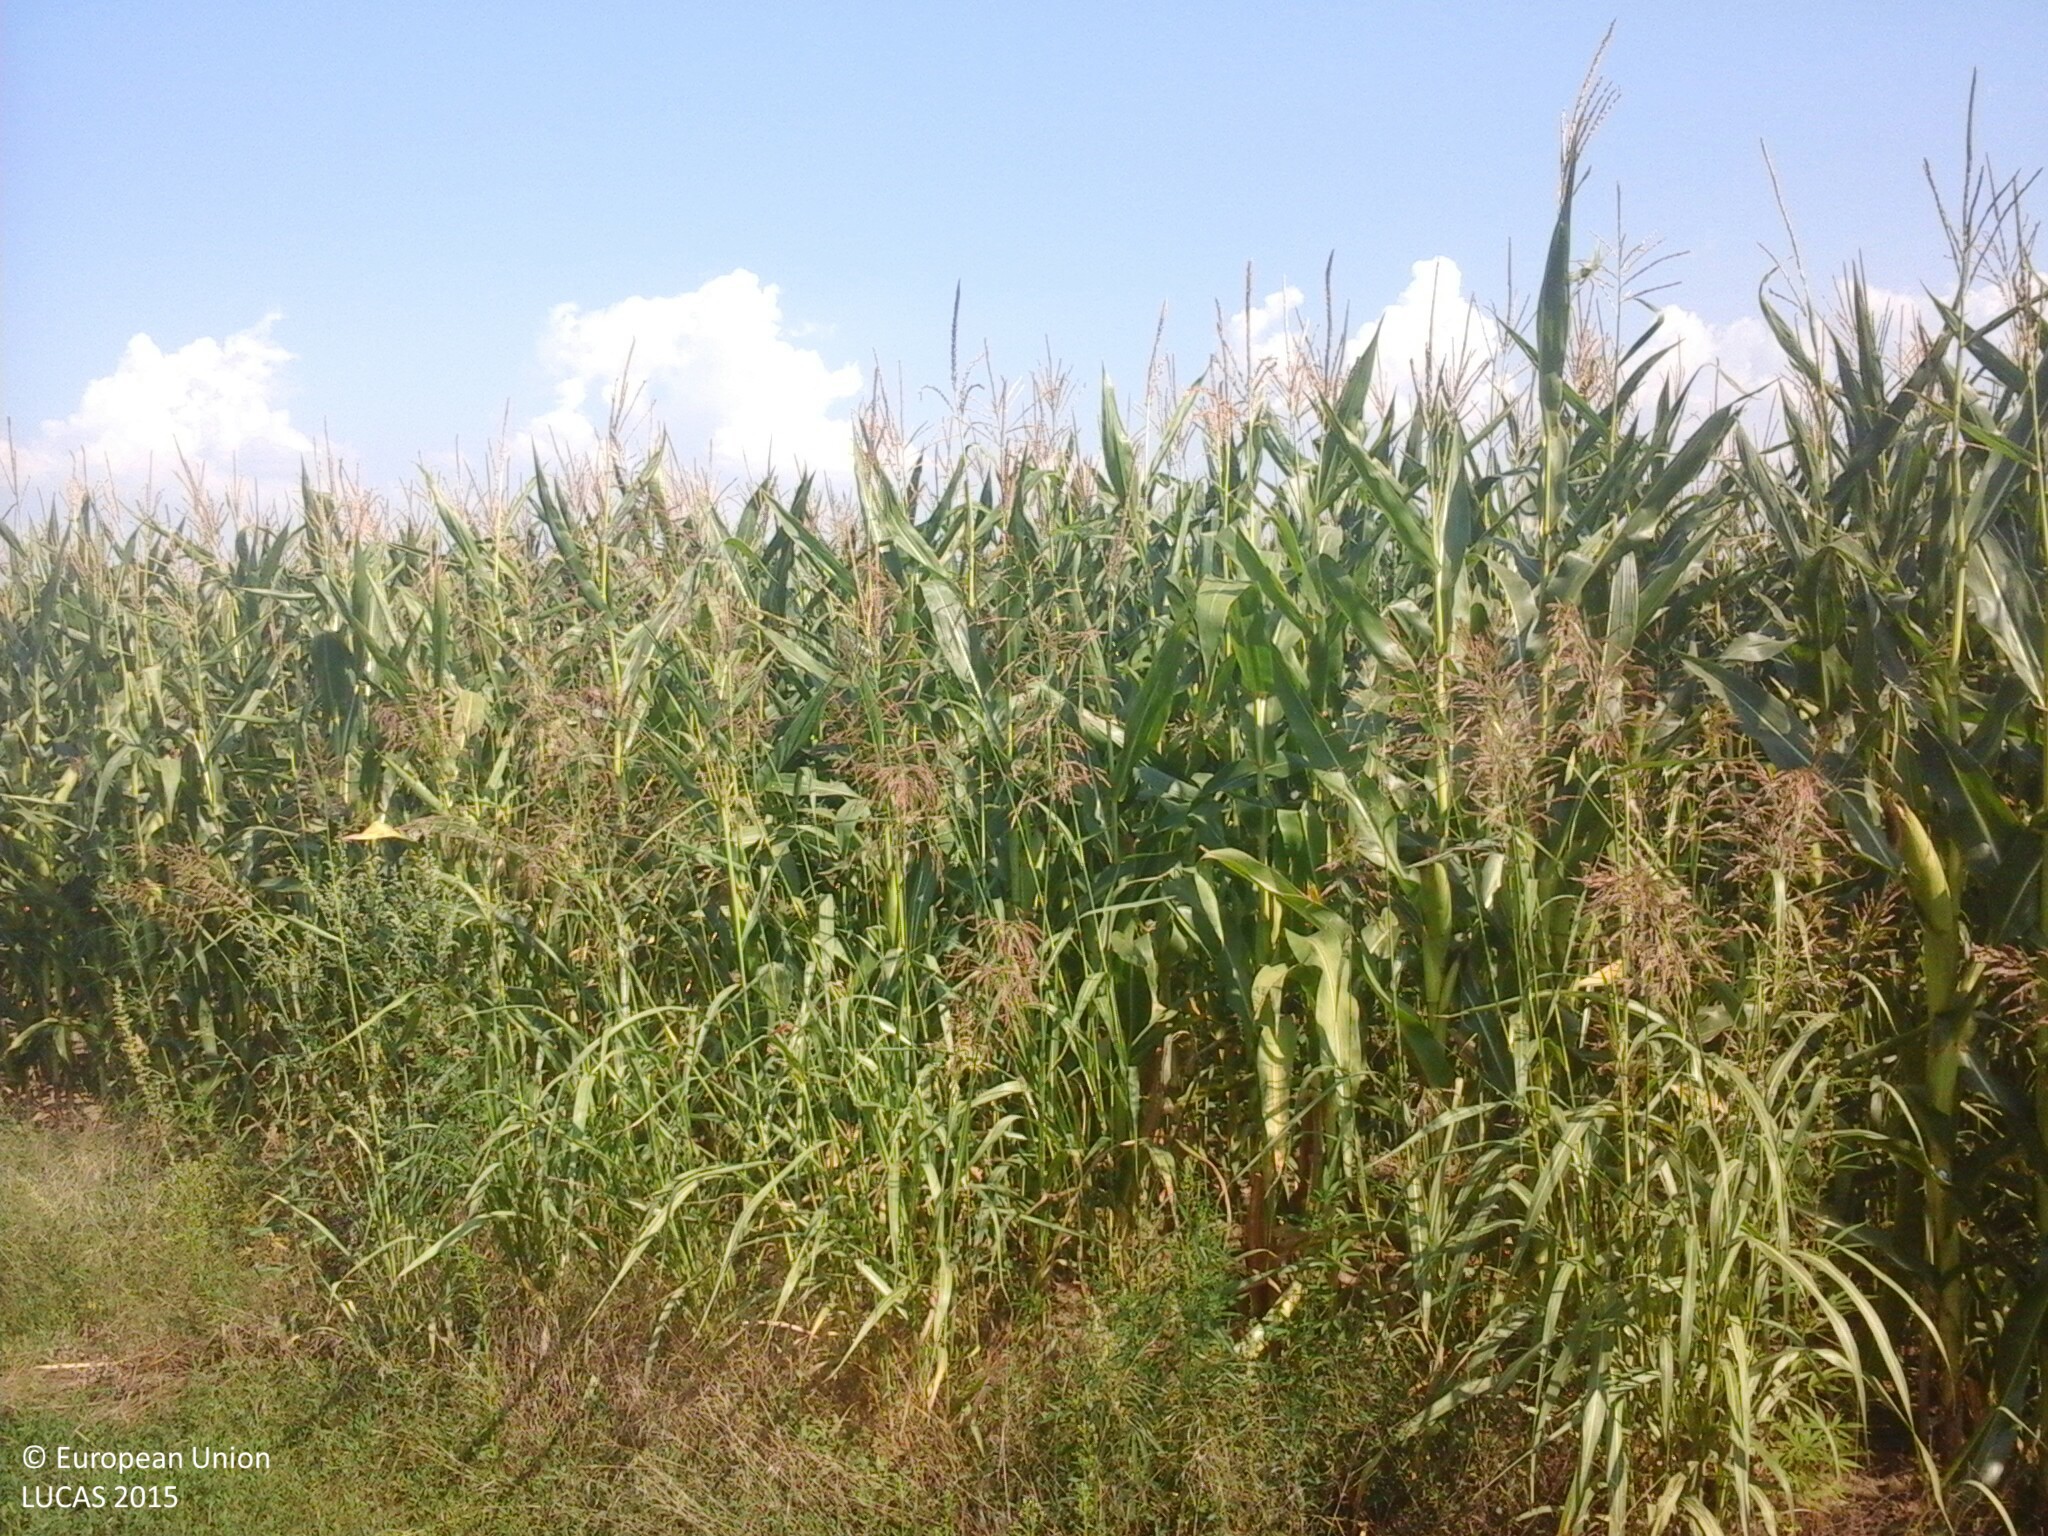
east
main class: Cropland
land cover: Maize
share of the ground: > 75 %
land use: Agriculture (excluding fallow land and kitchen gardens)
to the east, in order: Maize; Grass margins; Tracks; Grass margins; Maize; Electric lines; Maize
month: August
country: HU
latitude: 46.7919
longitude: 18.4873
